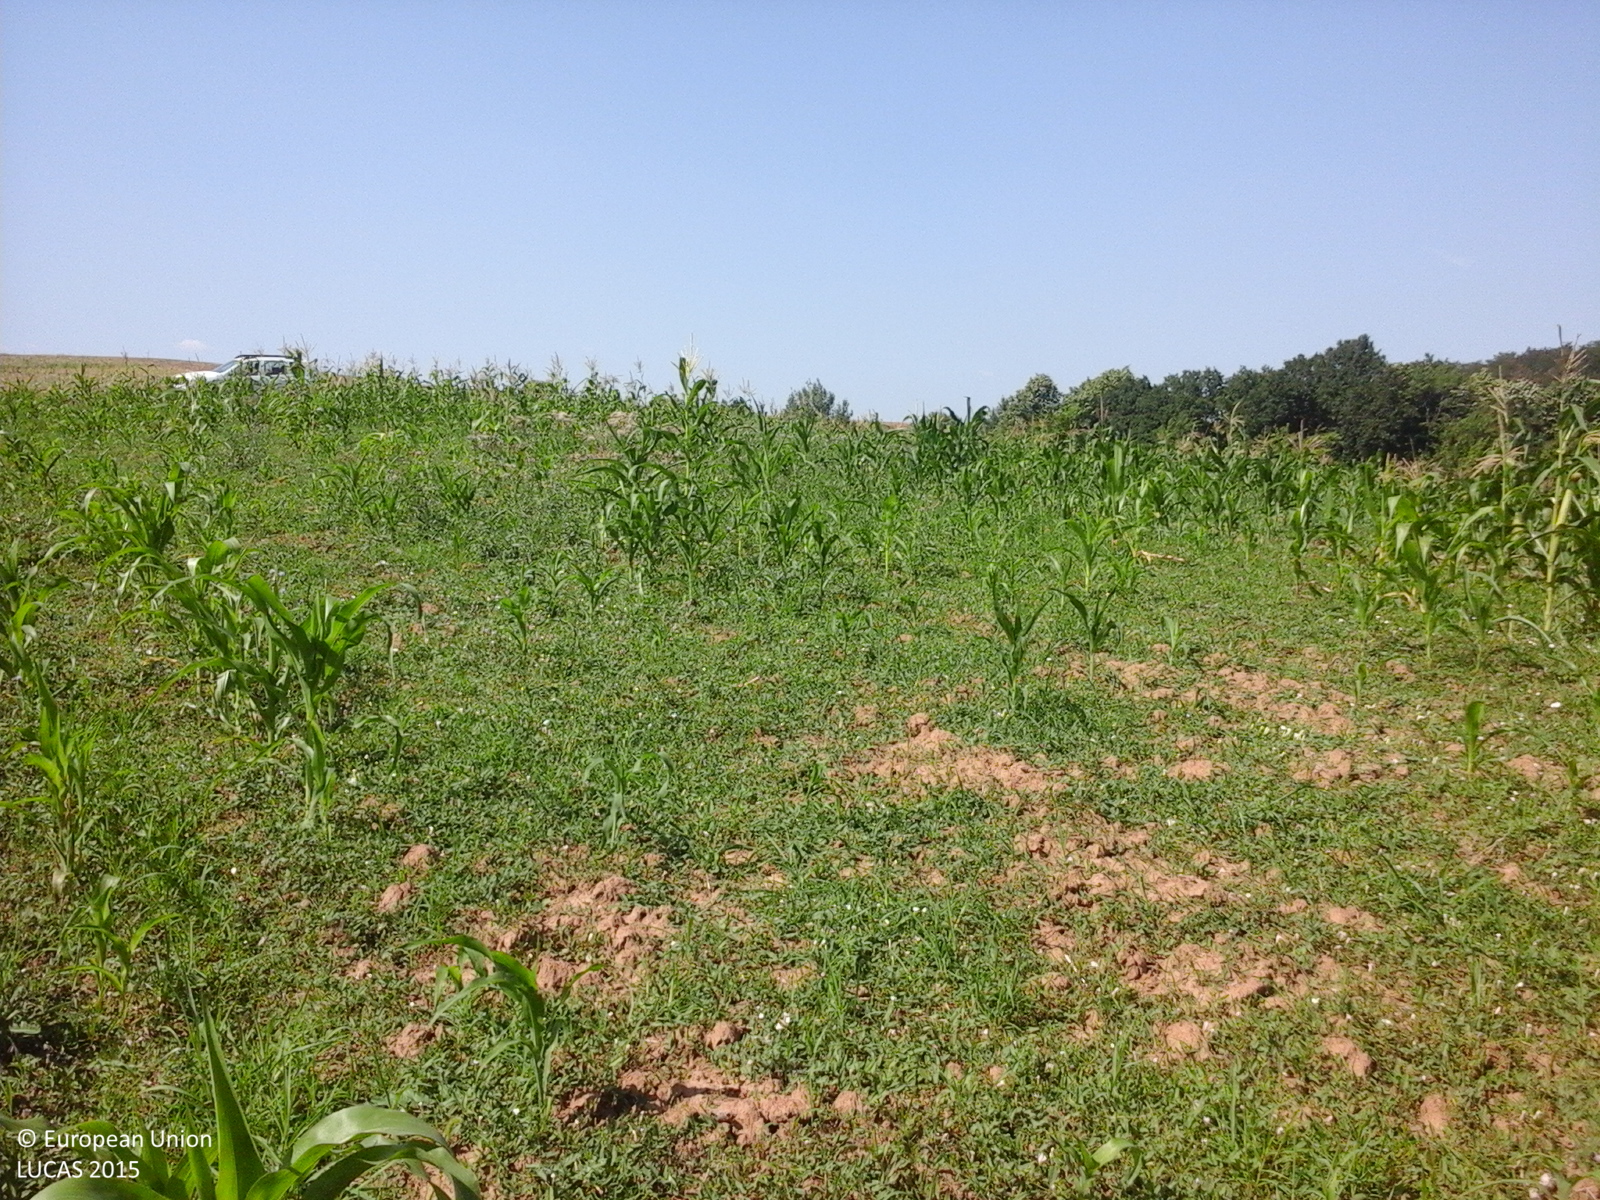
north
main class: Cropland
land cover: Maize
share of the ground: 25 - 50 %
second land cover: Spontaneously vegetated surfaces
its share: > 75 %
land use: Agriculture (excluding fallow land and kitchen gardens)
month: August
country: RO
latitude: 46.2649
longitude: 26.9998
